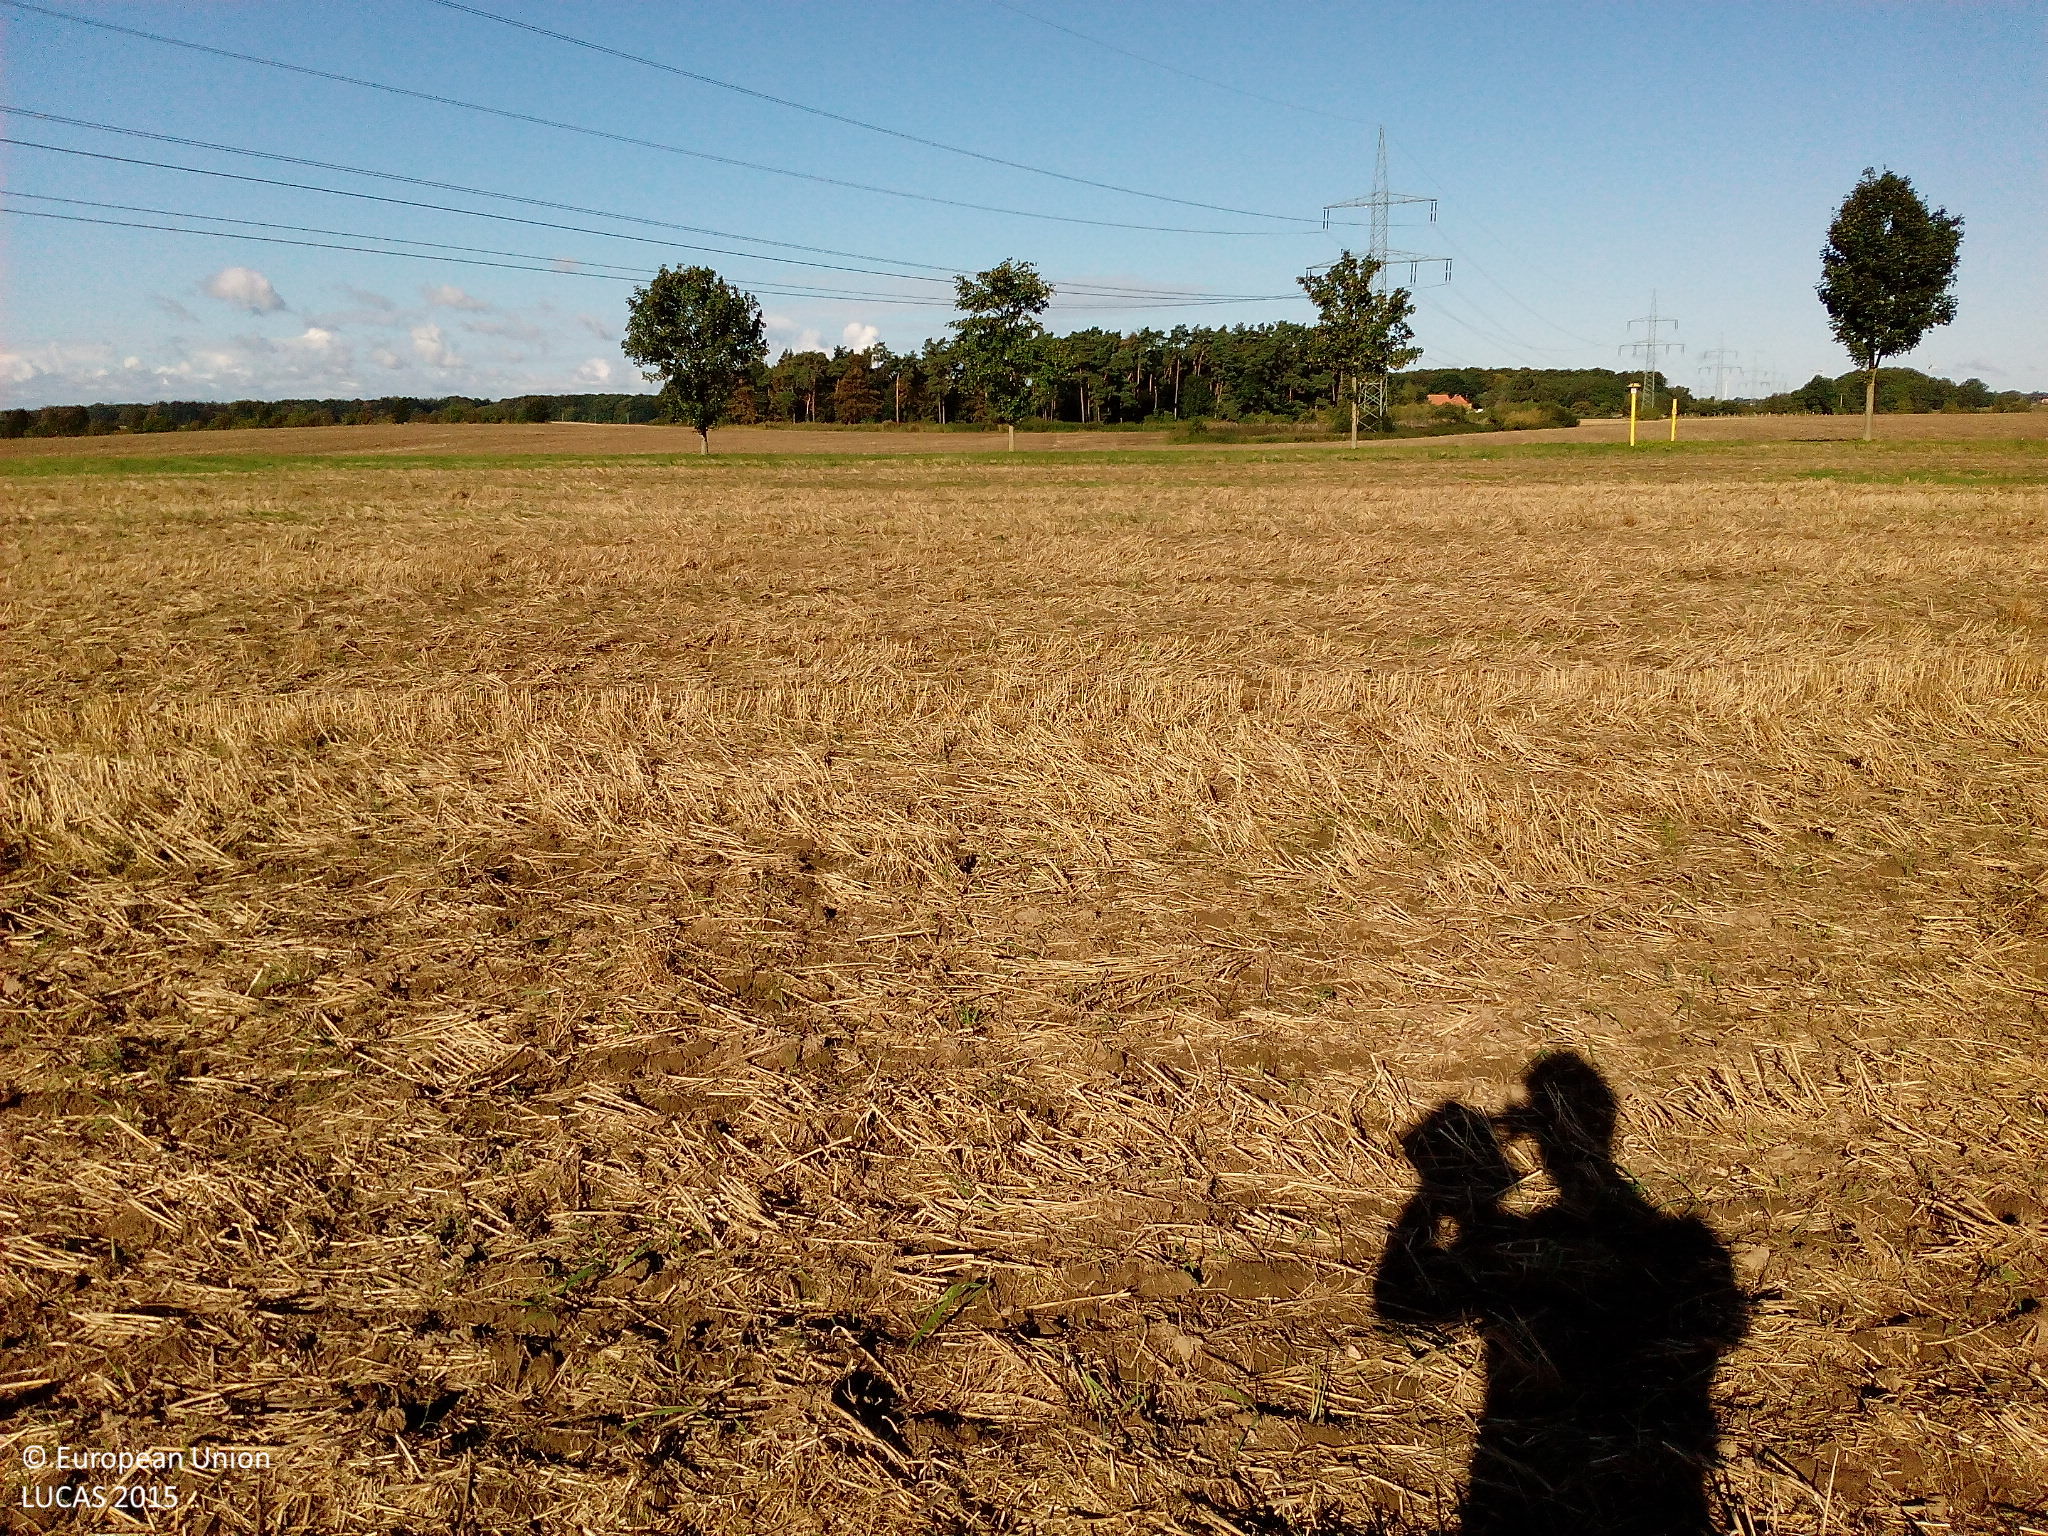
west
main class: Cropland
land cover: Common wheat
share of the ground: 10 - 25 %
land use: Agriculture (excluding fallow land and kitchen gardens)
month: September
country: DE
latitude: 54.0806
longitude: 12.3377
